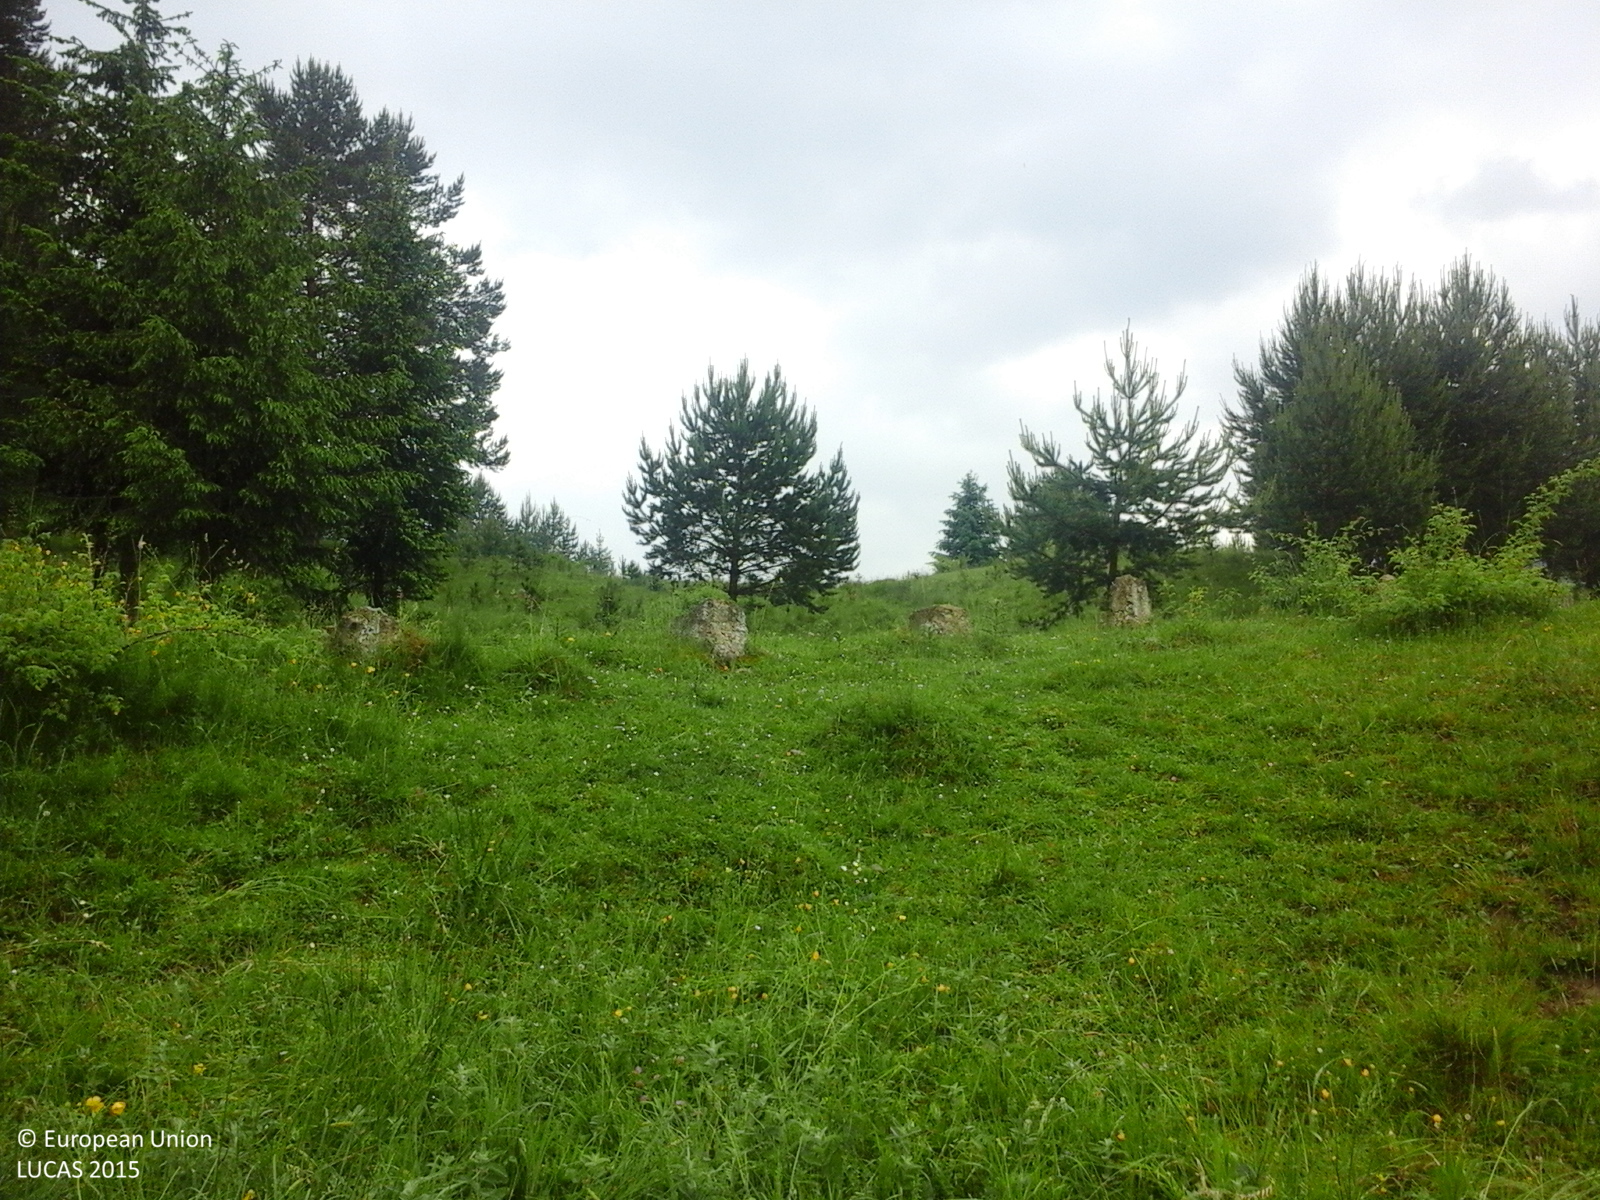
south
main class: Grassland
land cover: Grassland without tree/shrub cover
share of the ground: > 75 %
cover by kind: herbaceous plants 100 %
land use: Agriculture (excluding fallow land and kitchen gardens)
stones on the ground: < 10 %
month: June
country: RO
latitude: 46.4100
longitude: 26.4316
